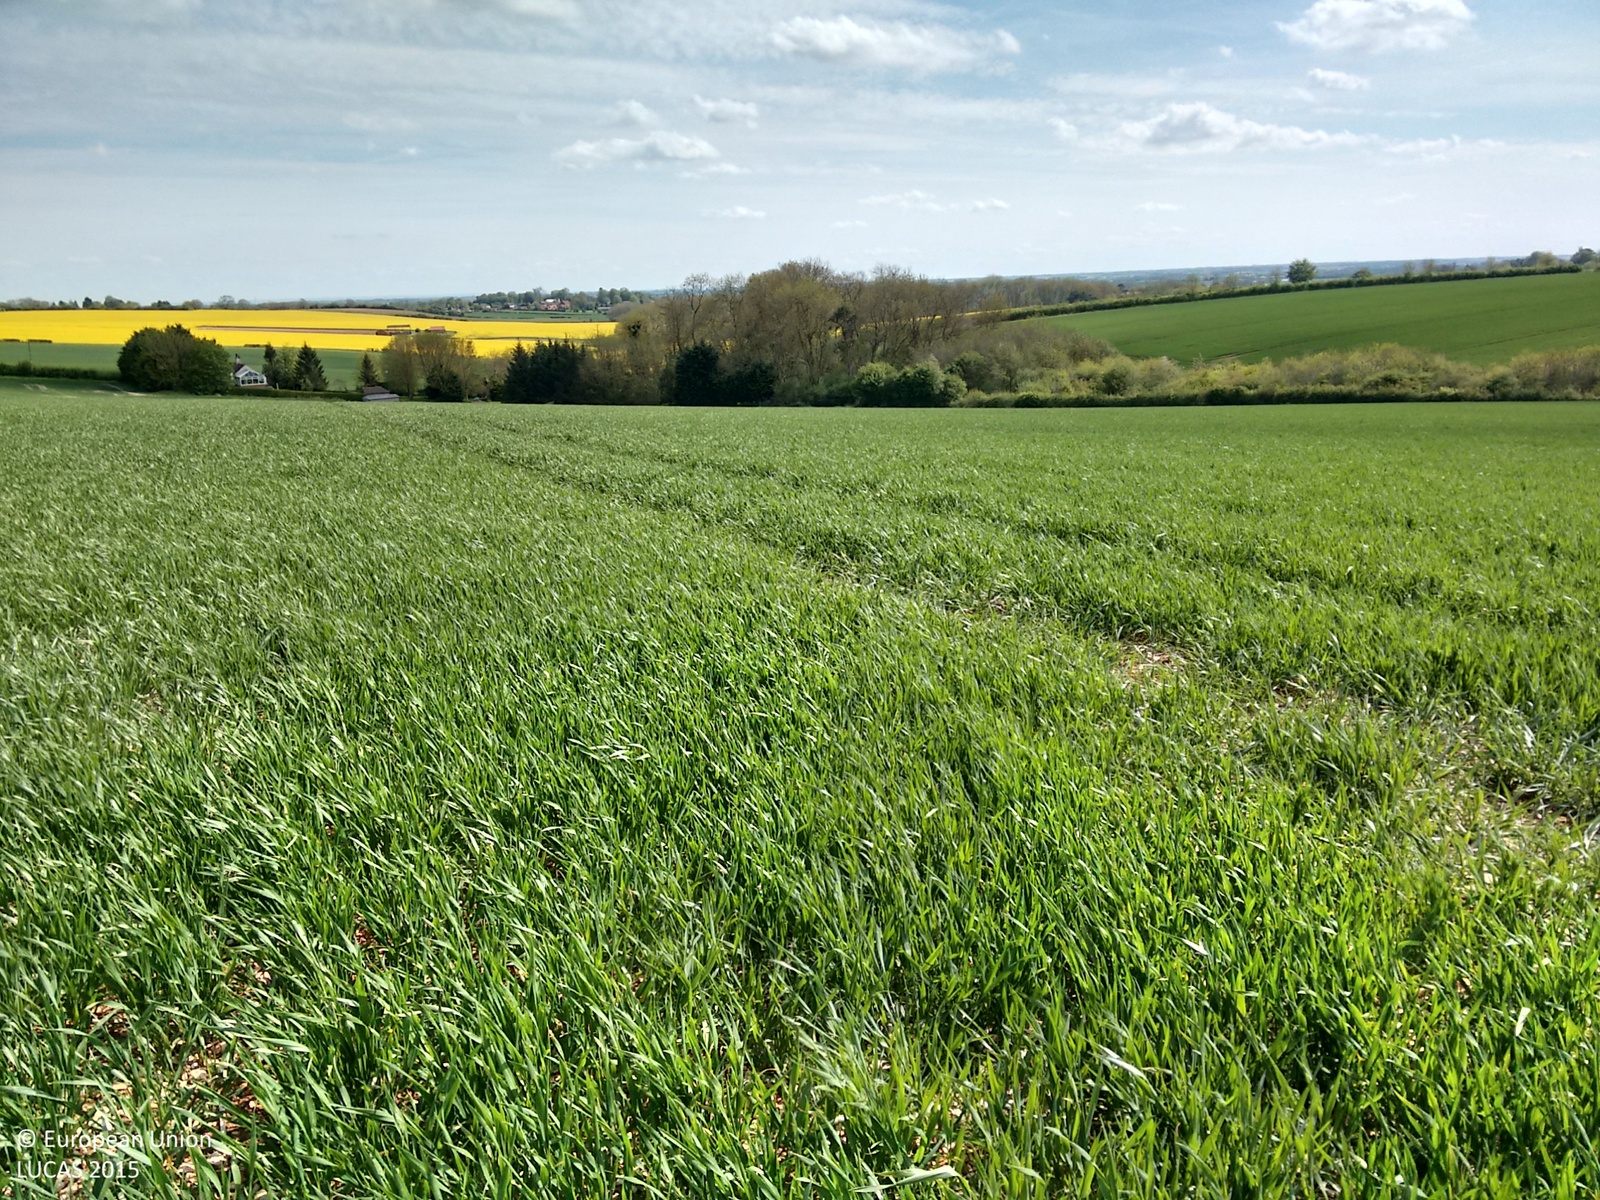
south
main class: Cropland
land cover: Common wheat
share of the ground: > 75 %
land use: Agriculture (excluding fallow land and kitchen gardens)
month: May
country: GB
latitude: 53.1999
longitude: 0.1644
